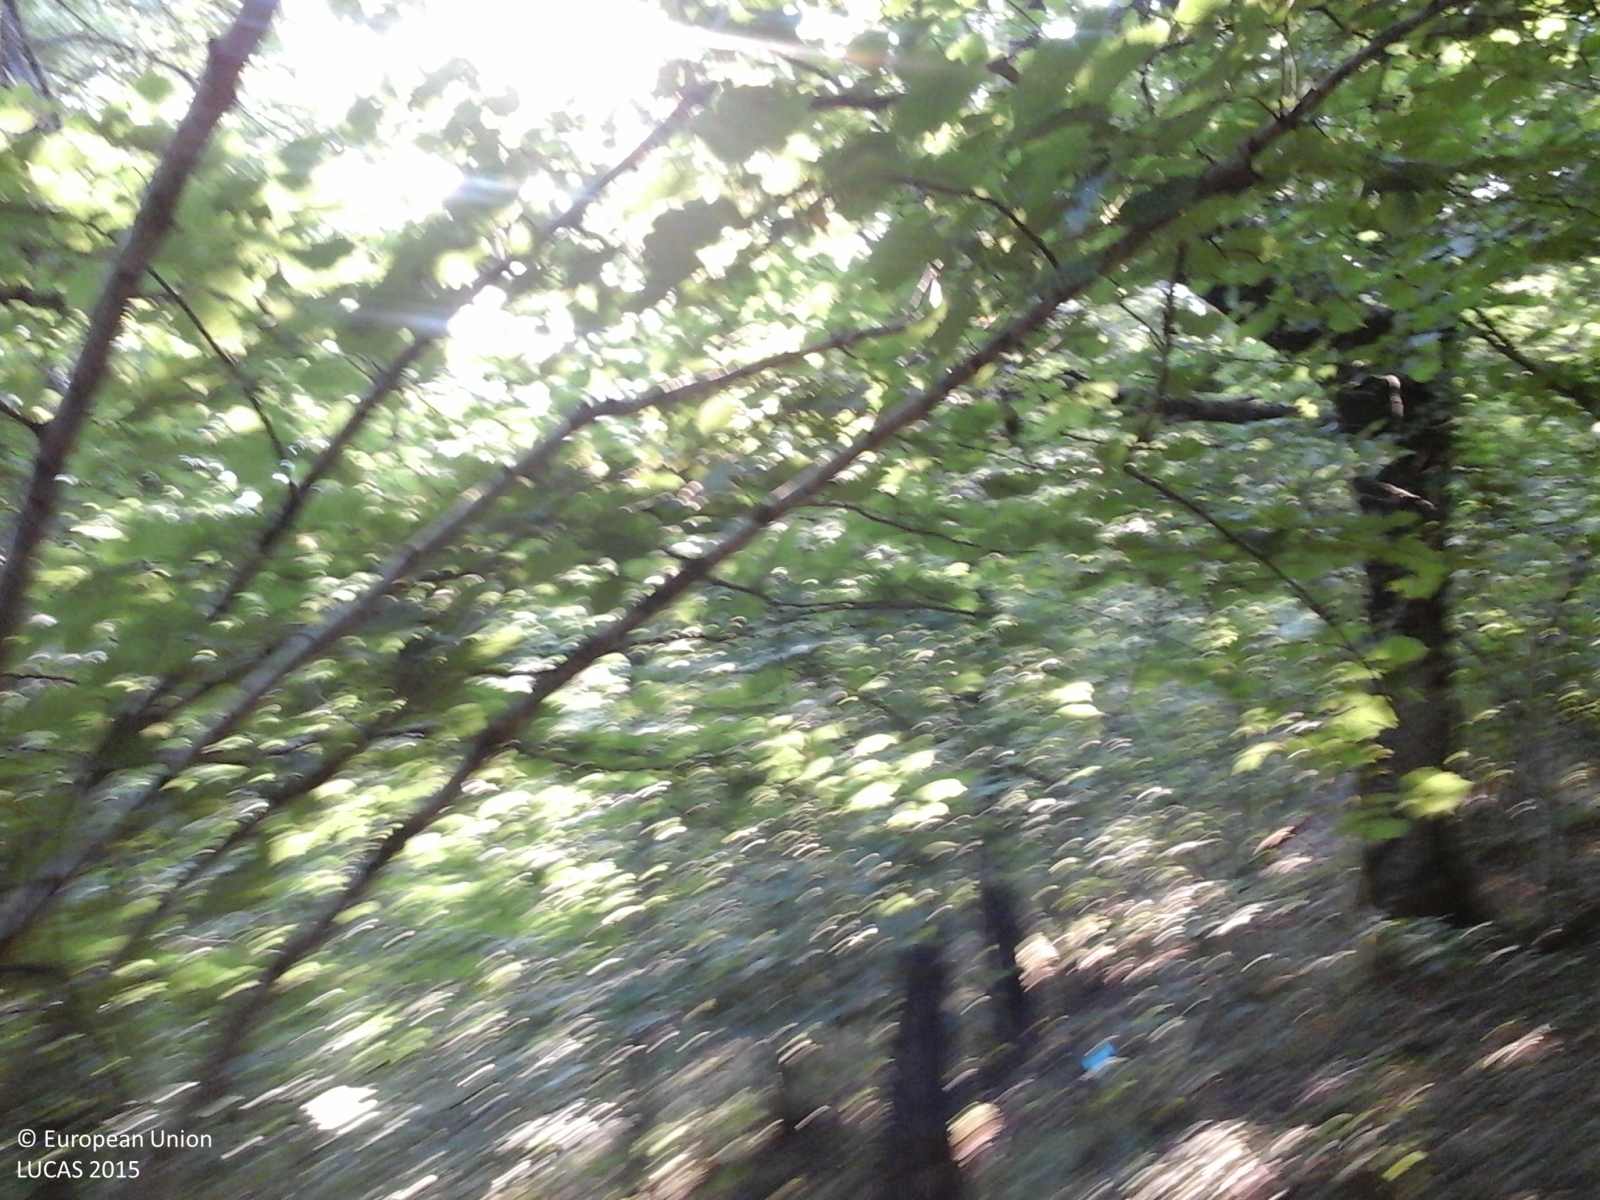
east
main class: Woodland
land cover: Broadleaved woodland
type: thermophilous deciduous forest
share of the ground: > 75 %
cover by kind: broadleaved forest trees 100 %
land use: Forestry
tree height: > 5 m
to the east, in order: Broadleaved woodland
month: August
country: IT
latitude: 43.6046
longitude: 12.2366
